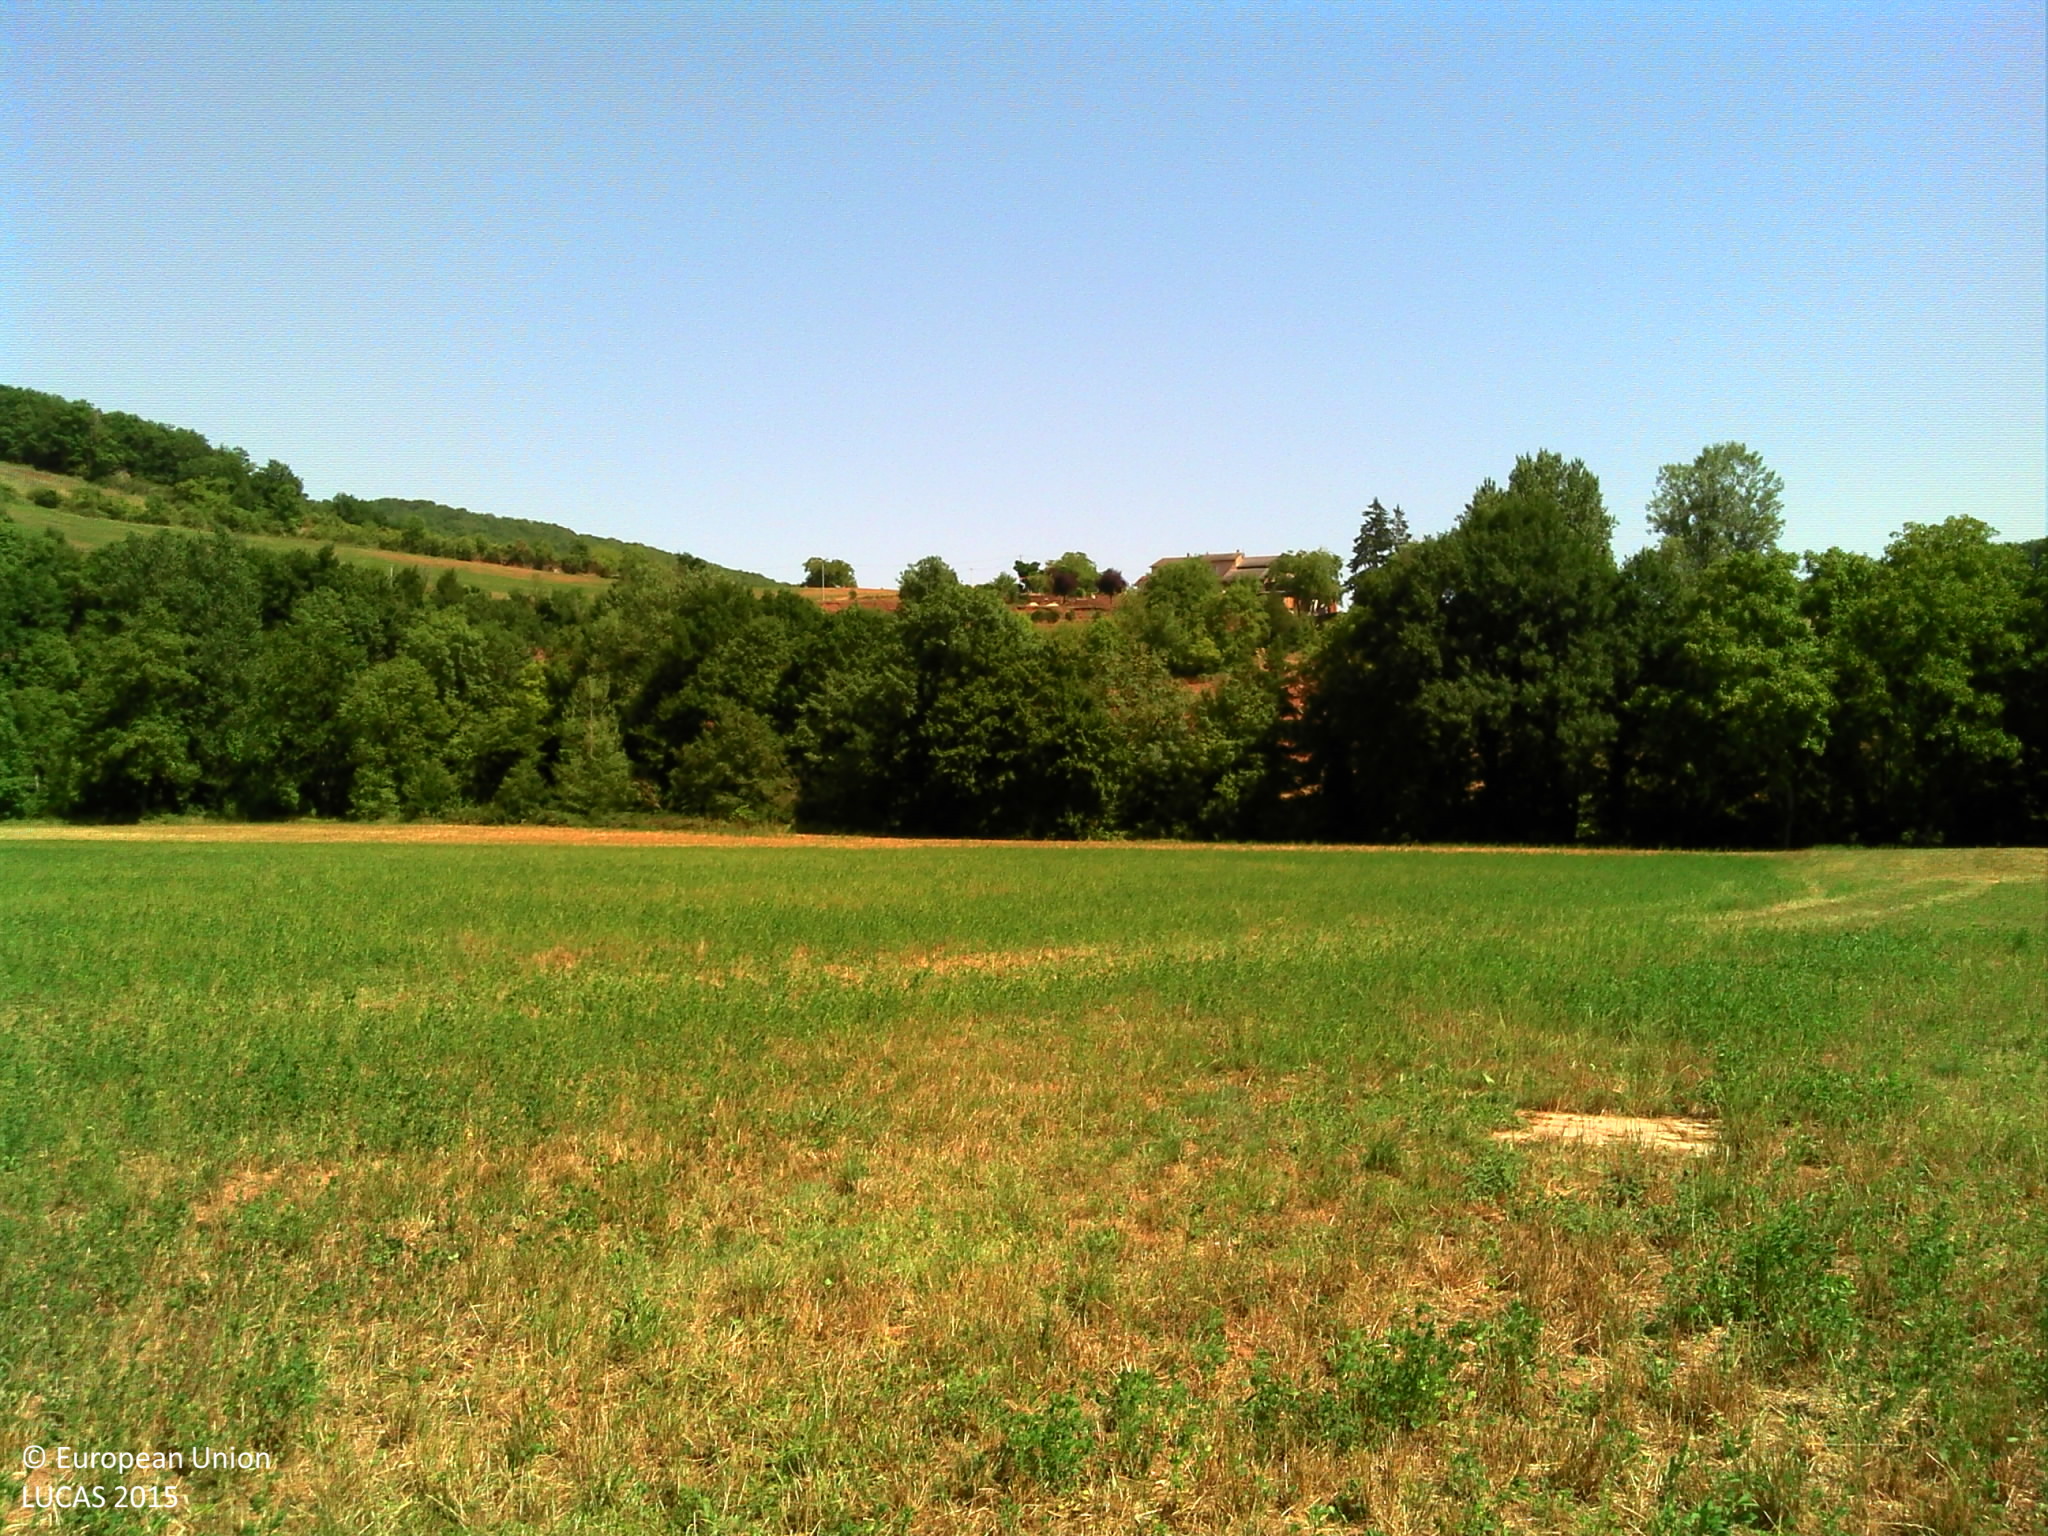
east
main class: Cropland
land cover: Temporary grasslands
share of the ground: > 75 %
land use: Agriculture (excluding fallow land and kitchen gardens)
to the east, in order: Temporary grasslands; Broadleaved woodland; Inland fresh running water; Broadleaved woodland; Barley
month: August
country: FR
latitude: 43.8528
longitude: 2.6288
